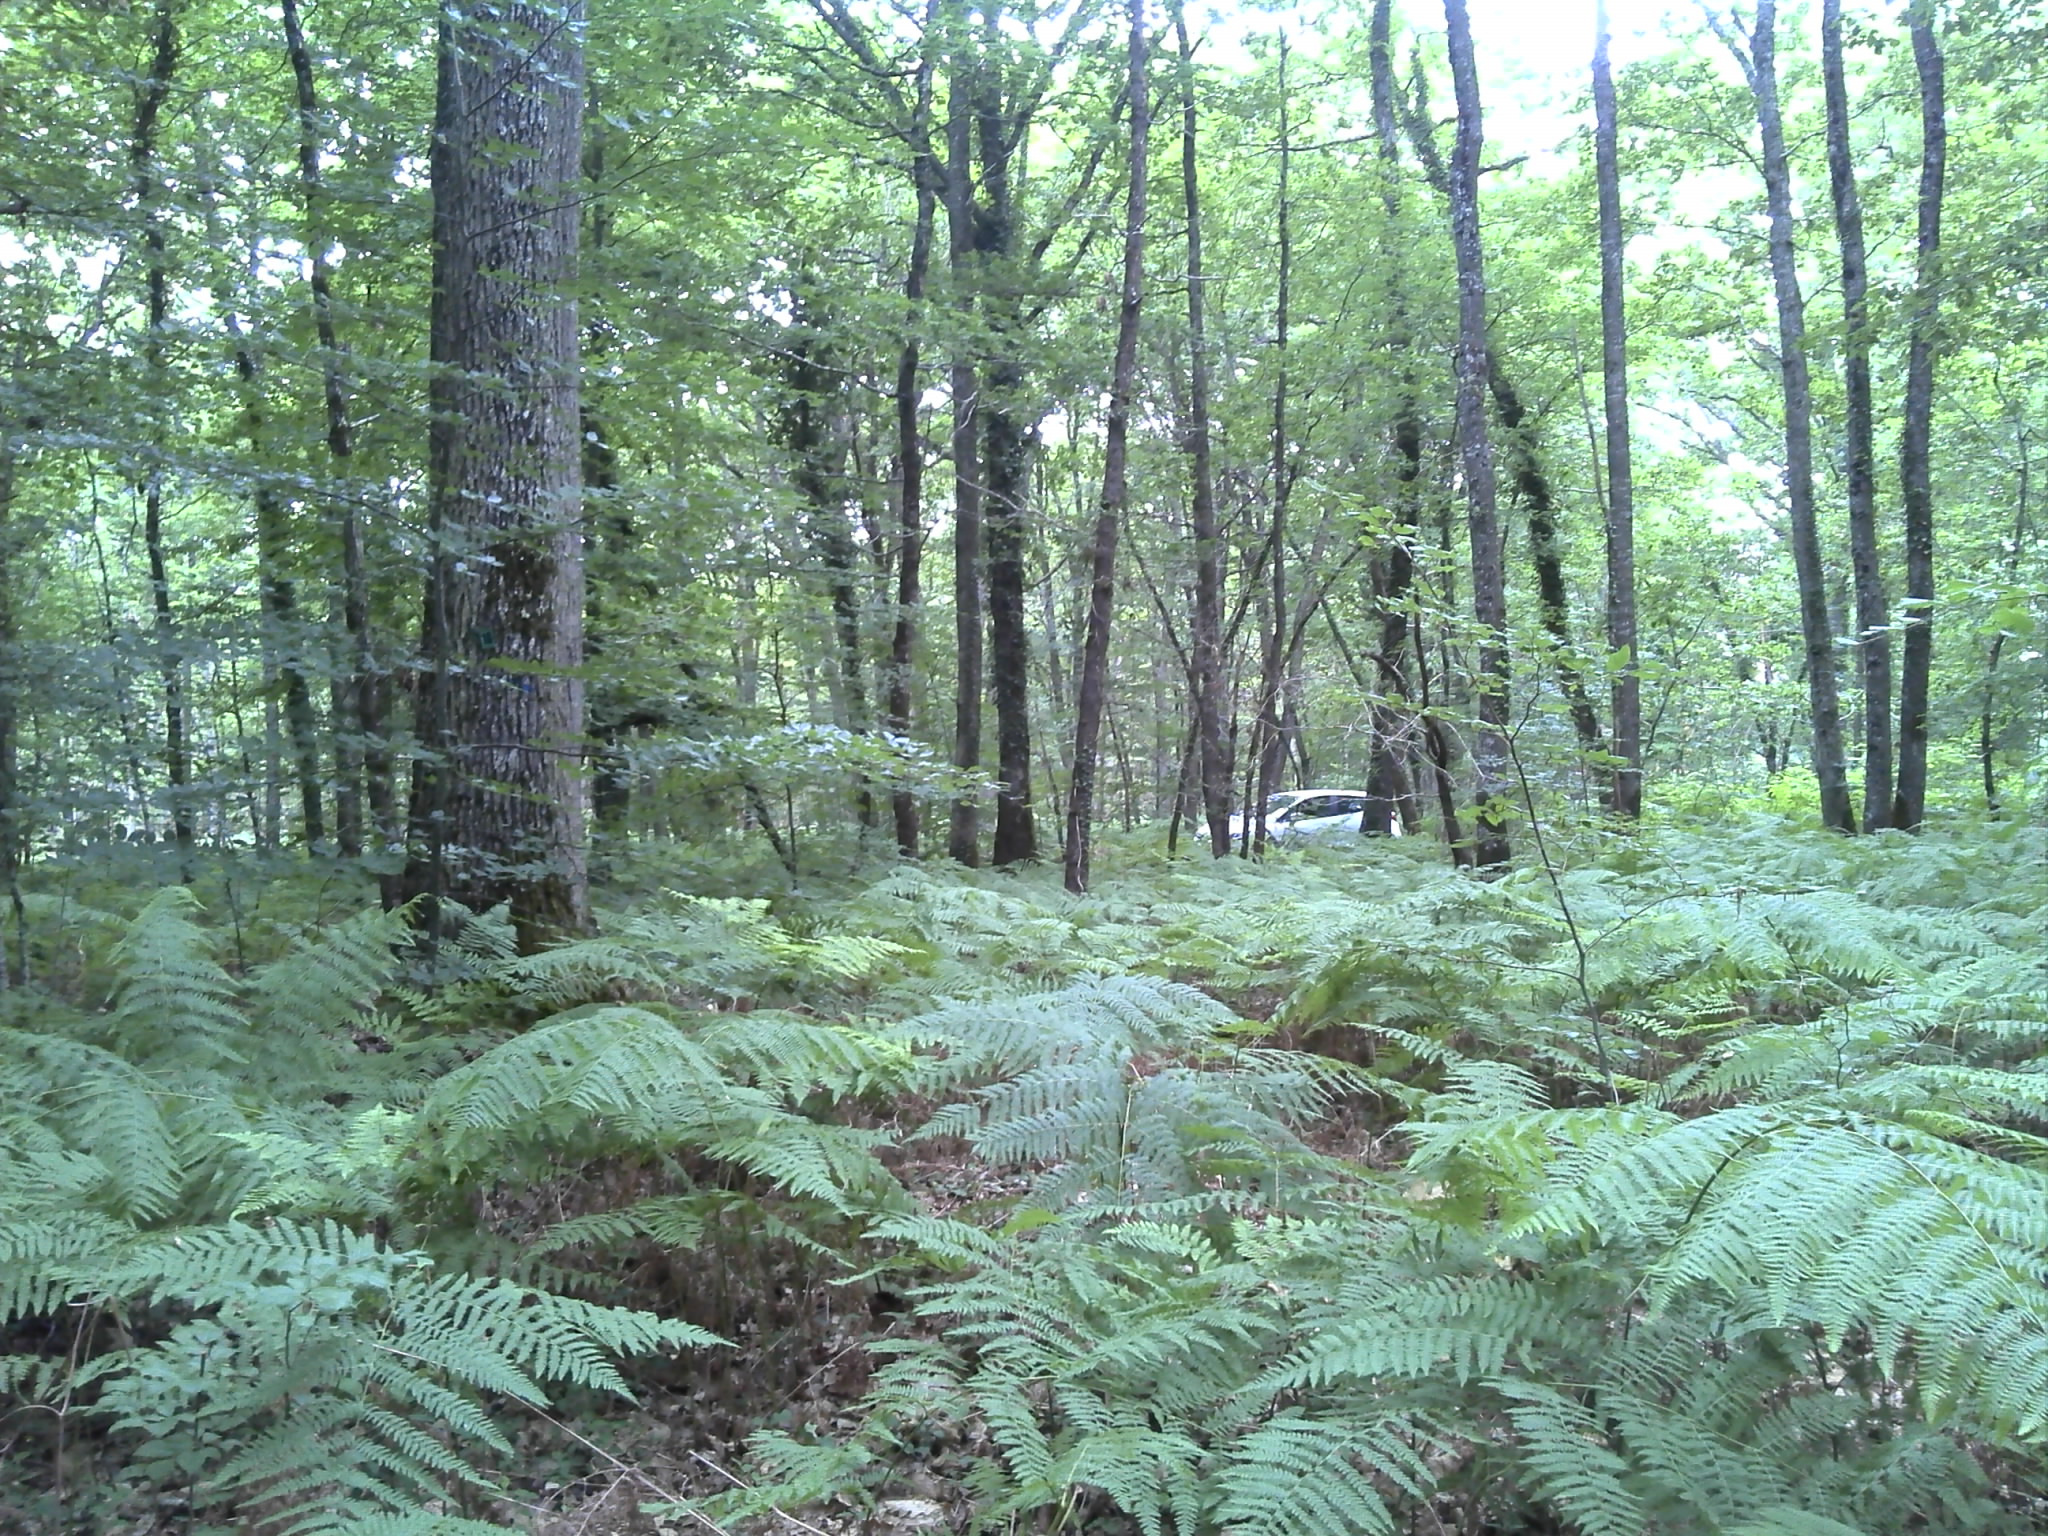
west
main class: Woodland
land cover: Broadleaved woodland
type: beech forest
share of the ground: > 75 %
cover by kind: broadleaved forest trees 90 %, herbaceous plants 5 %, lichens and mosses 5 %
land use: Forestry
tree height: > 5 m
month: June
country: FR
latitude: 47.1734
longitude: 1.5302
